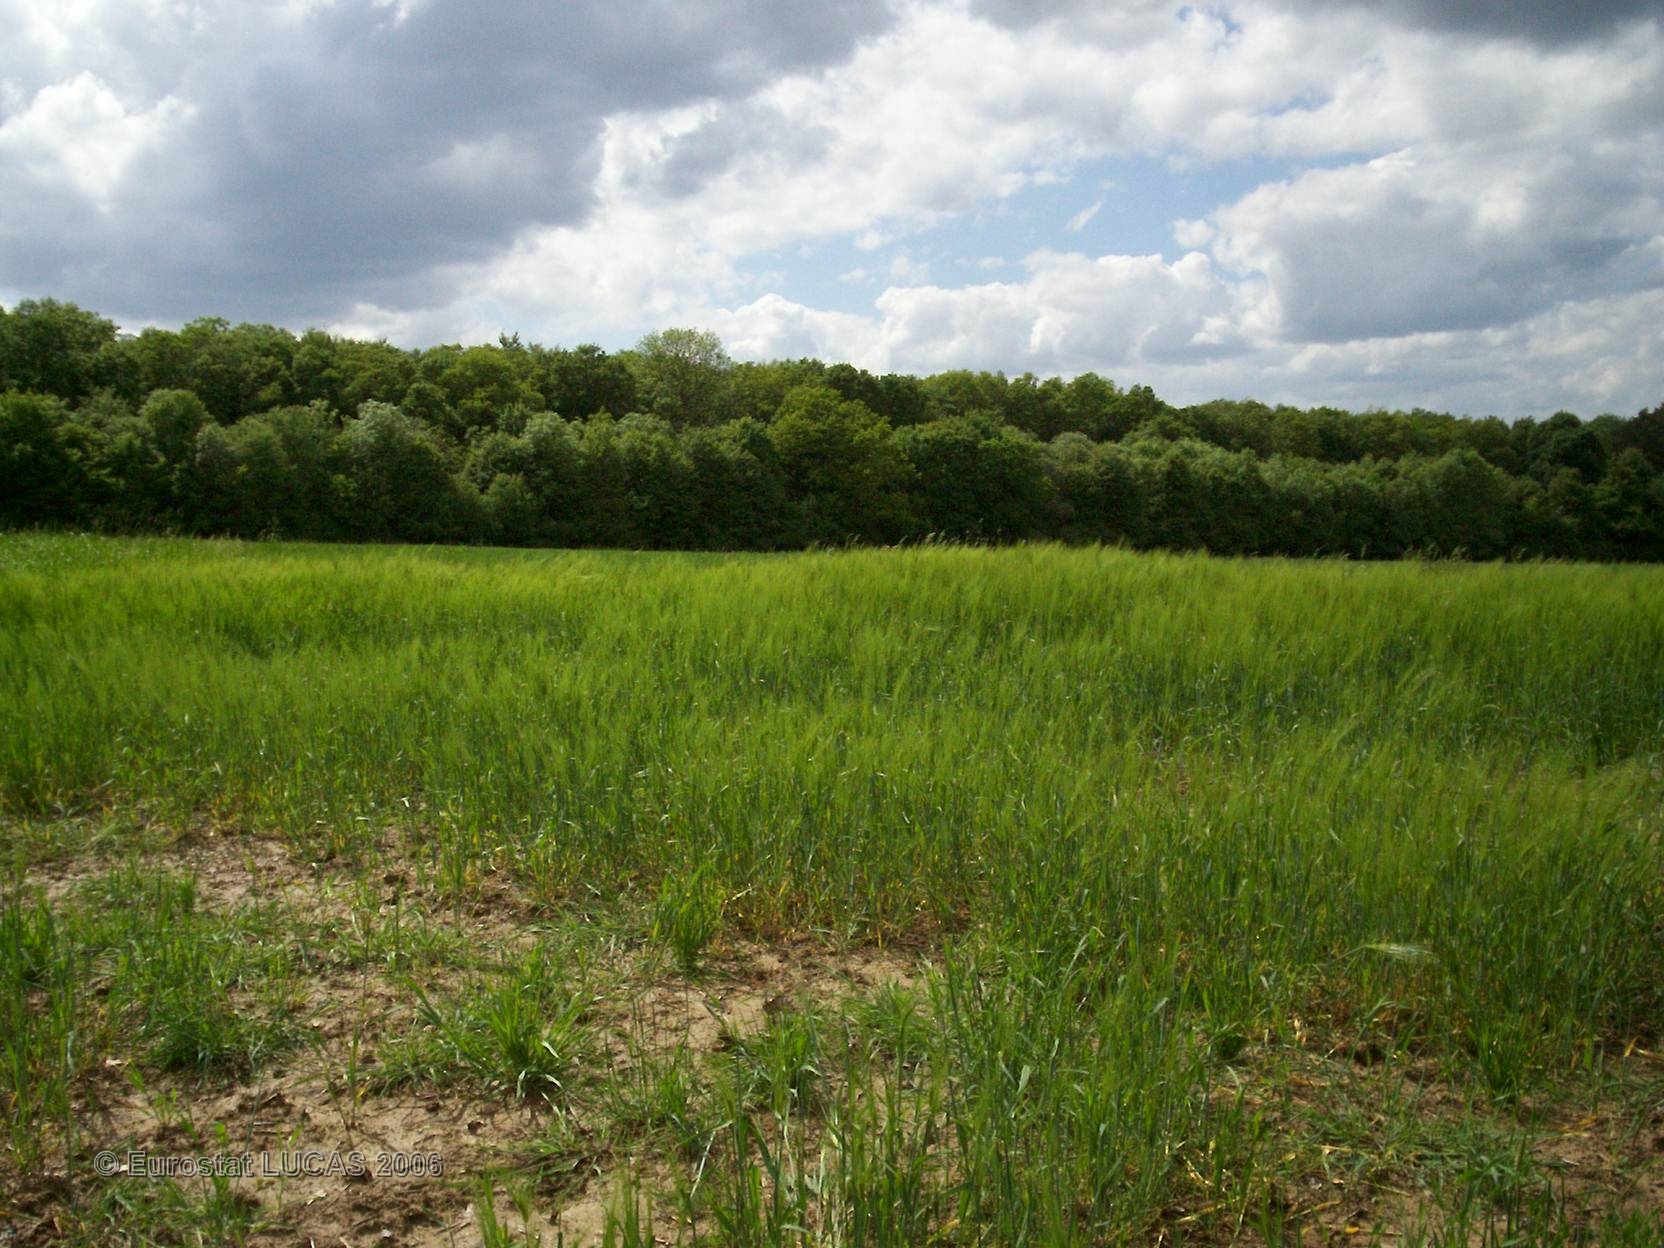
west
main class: Cropland
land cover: Barley
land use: Agriculture (excluding fallow land and kitchen gardens)
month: May
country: FR
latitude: 48.6441
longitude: 6.7567
